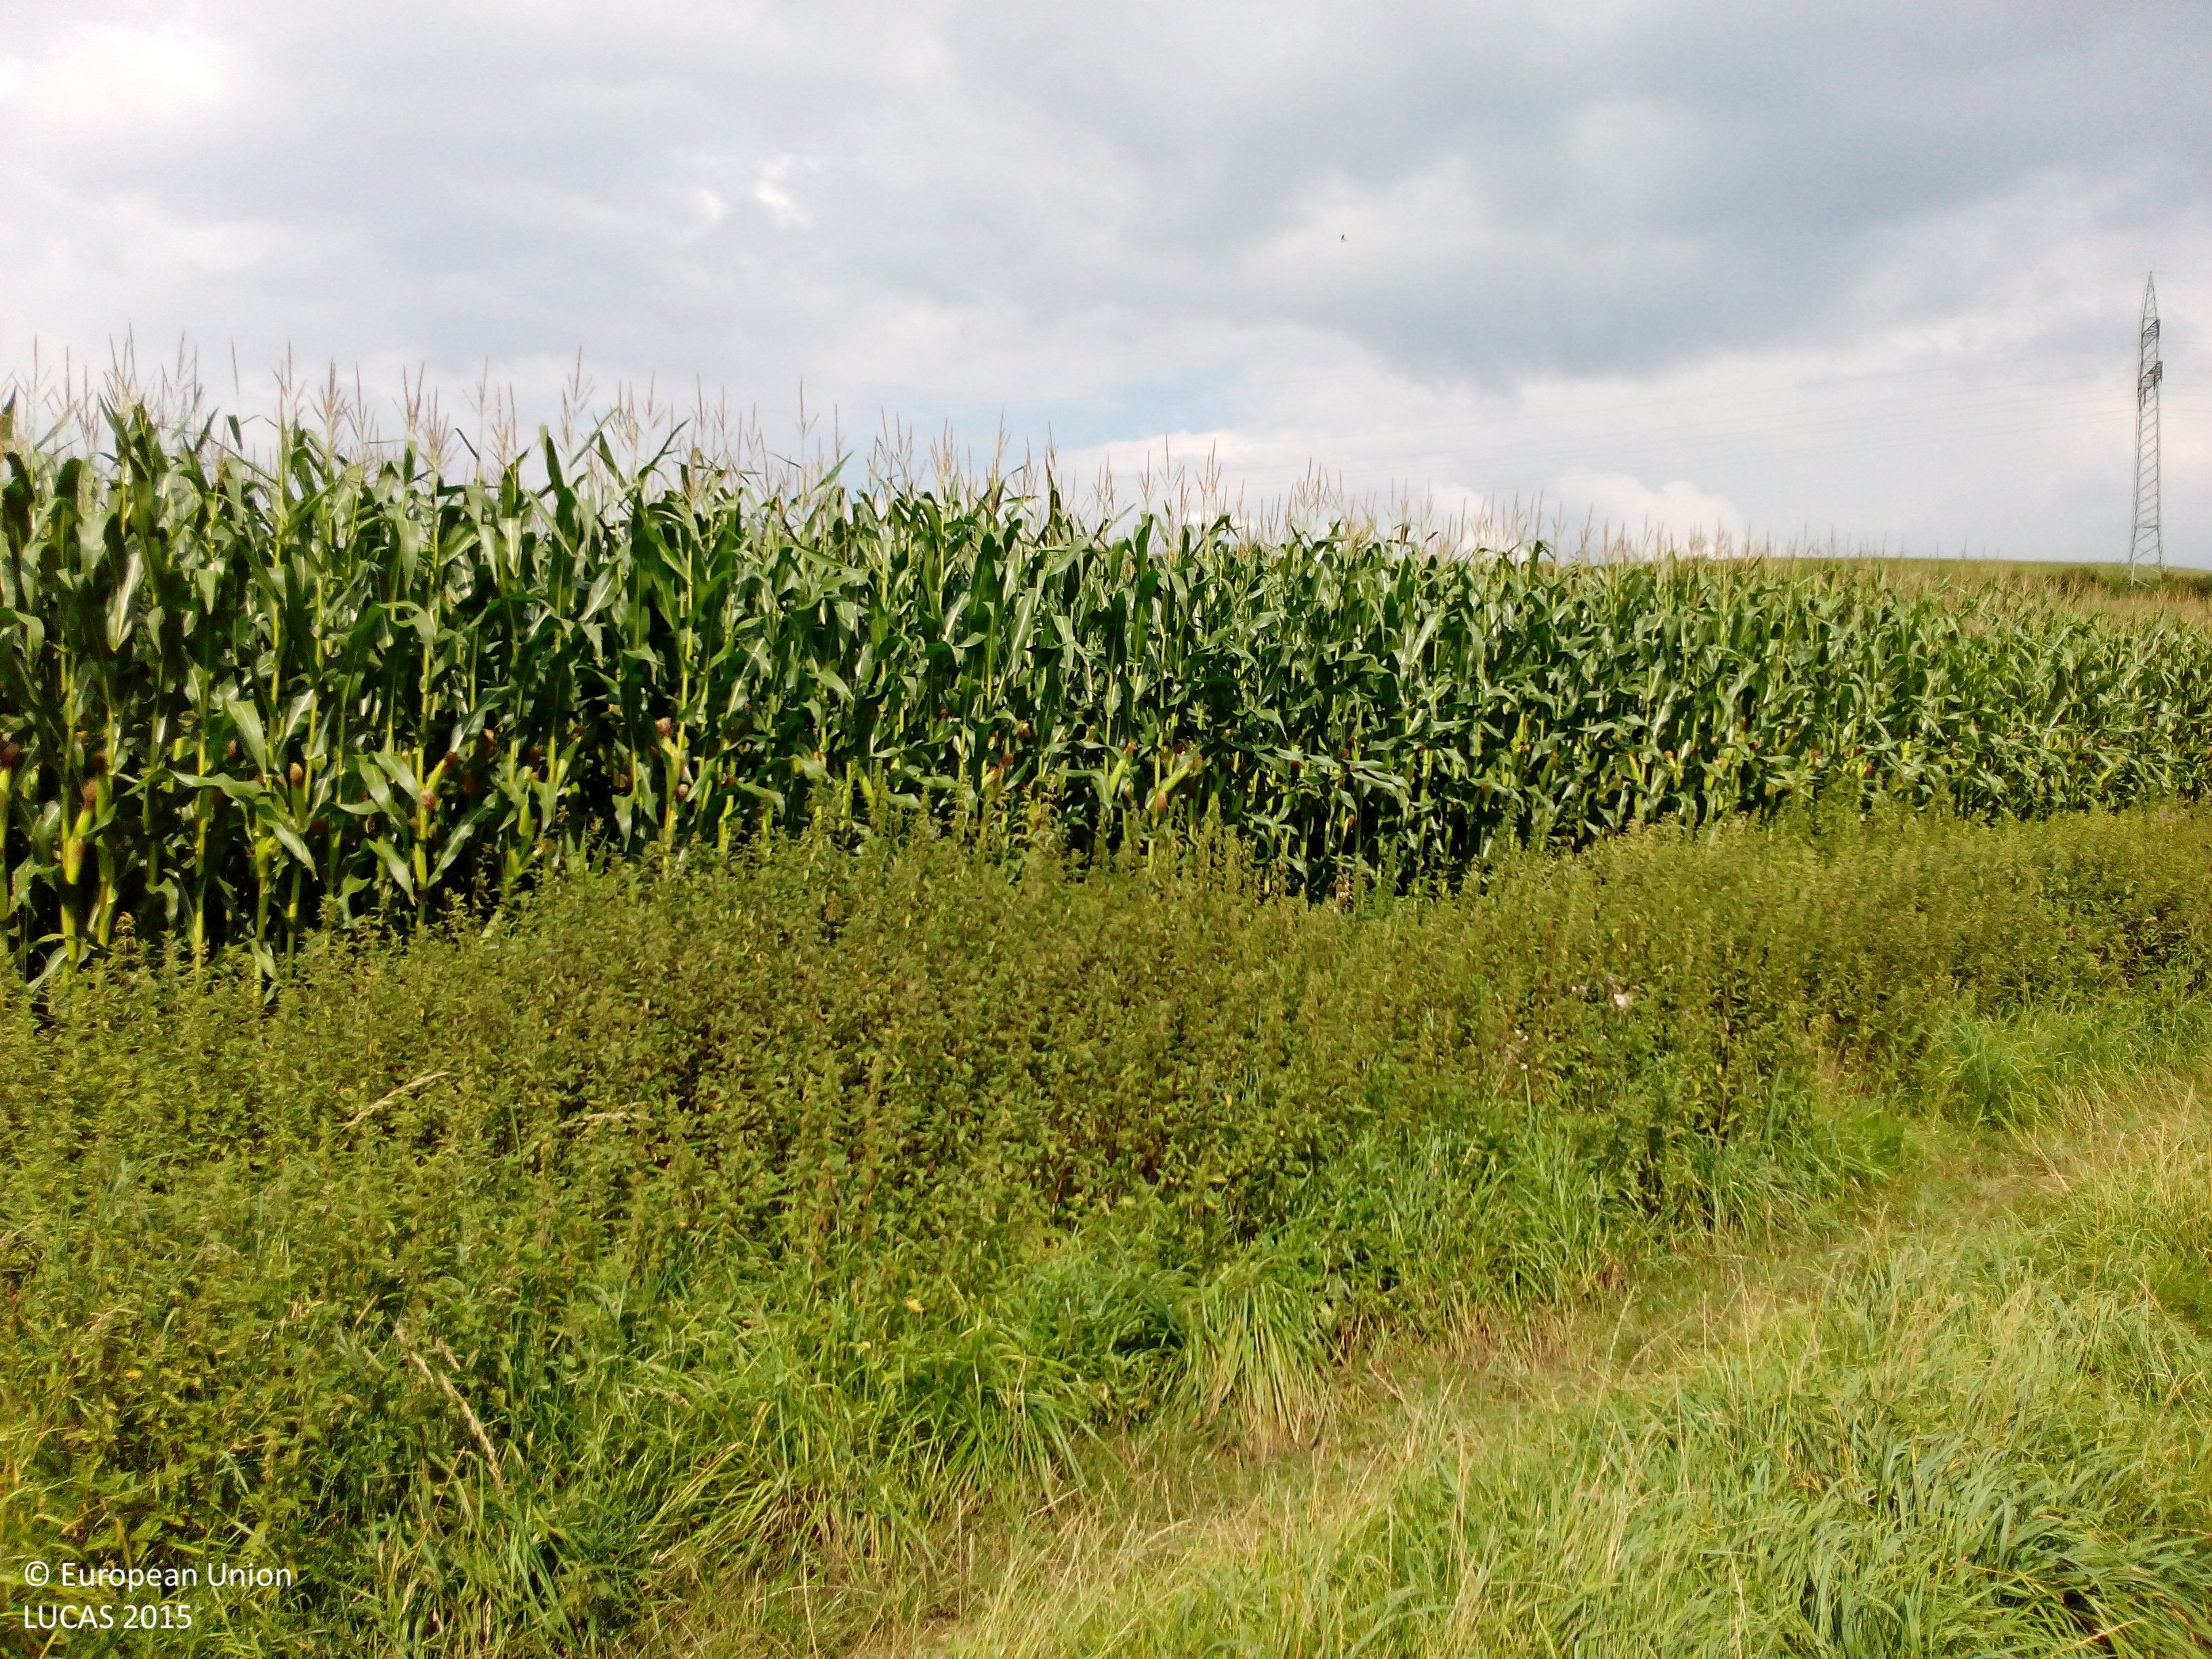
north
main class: Cropland
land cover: Maize
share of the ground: > 75 %
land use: Agriculture (excluding fallow land and kitchen gardens)
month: August
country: DE
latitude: 51.6941
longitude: 10.2748
